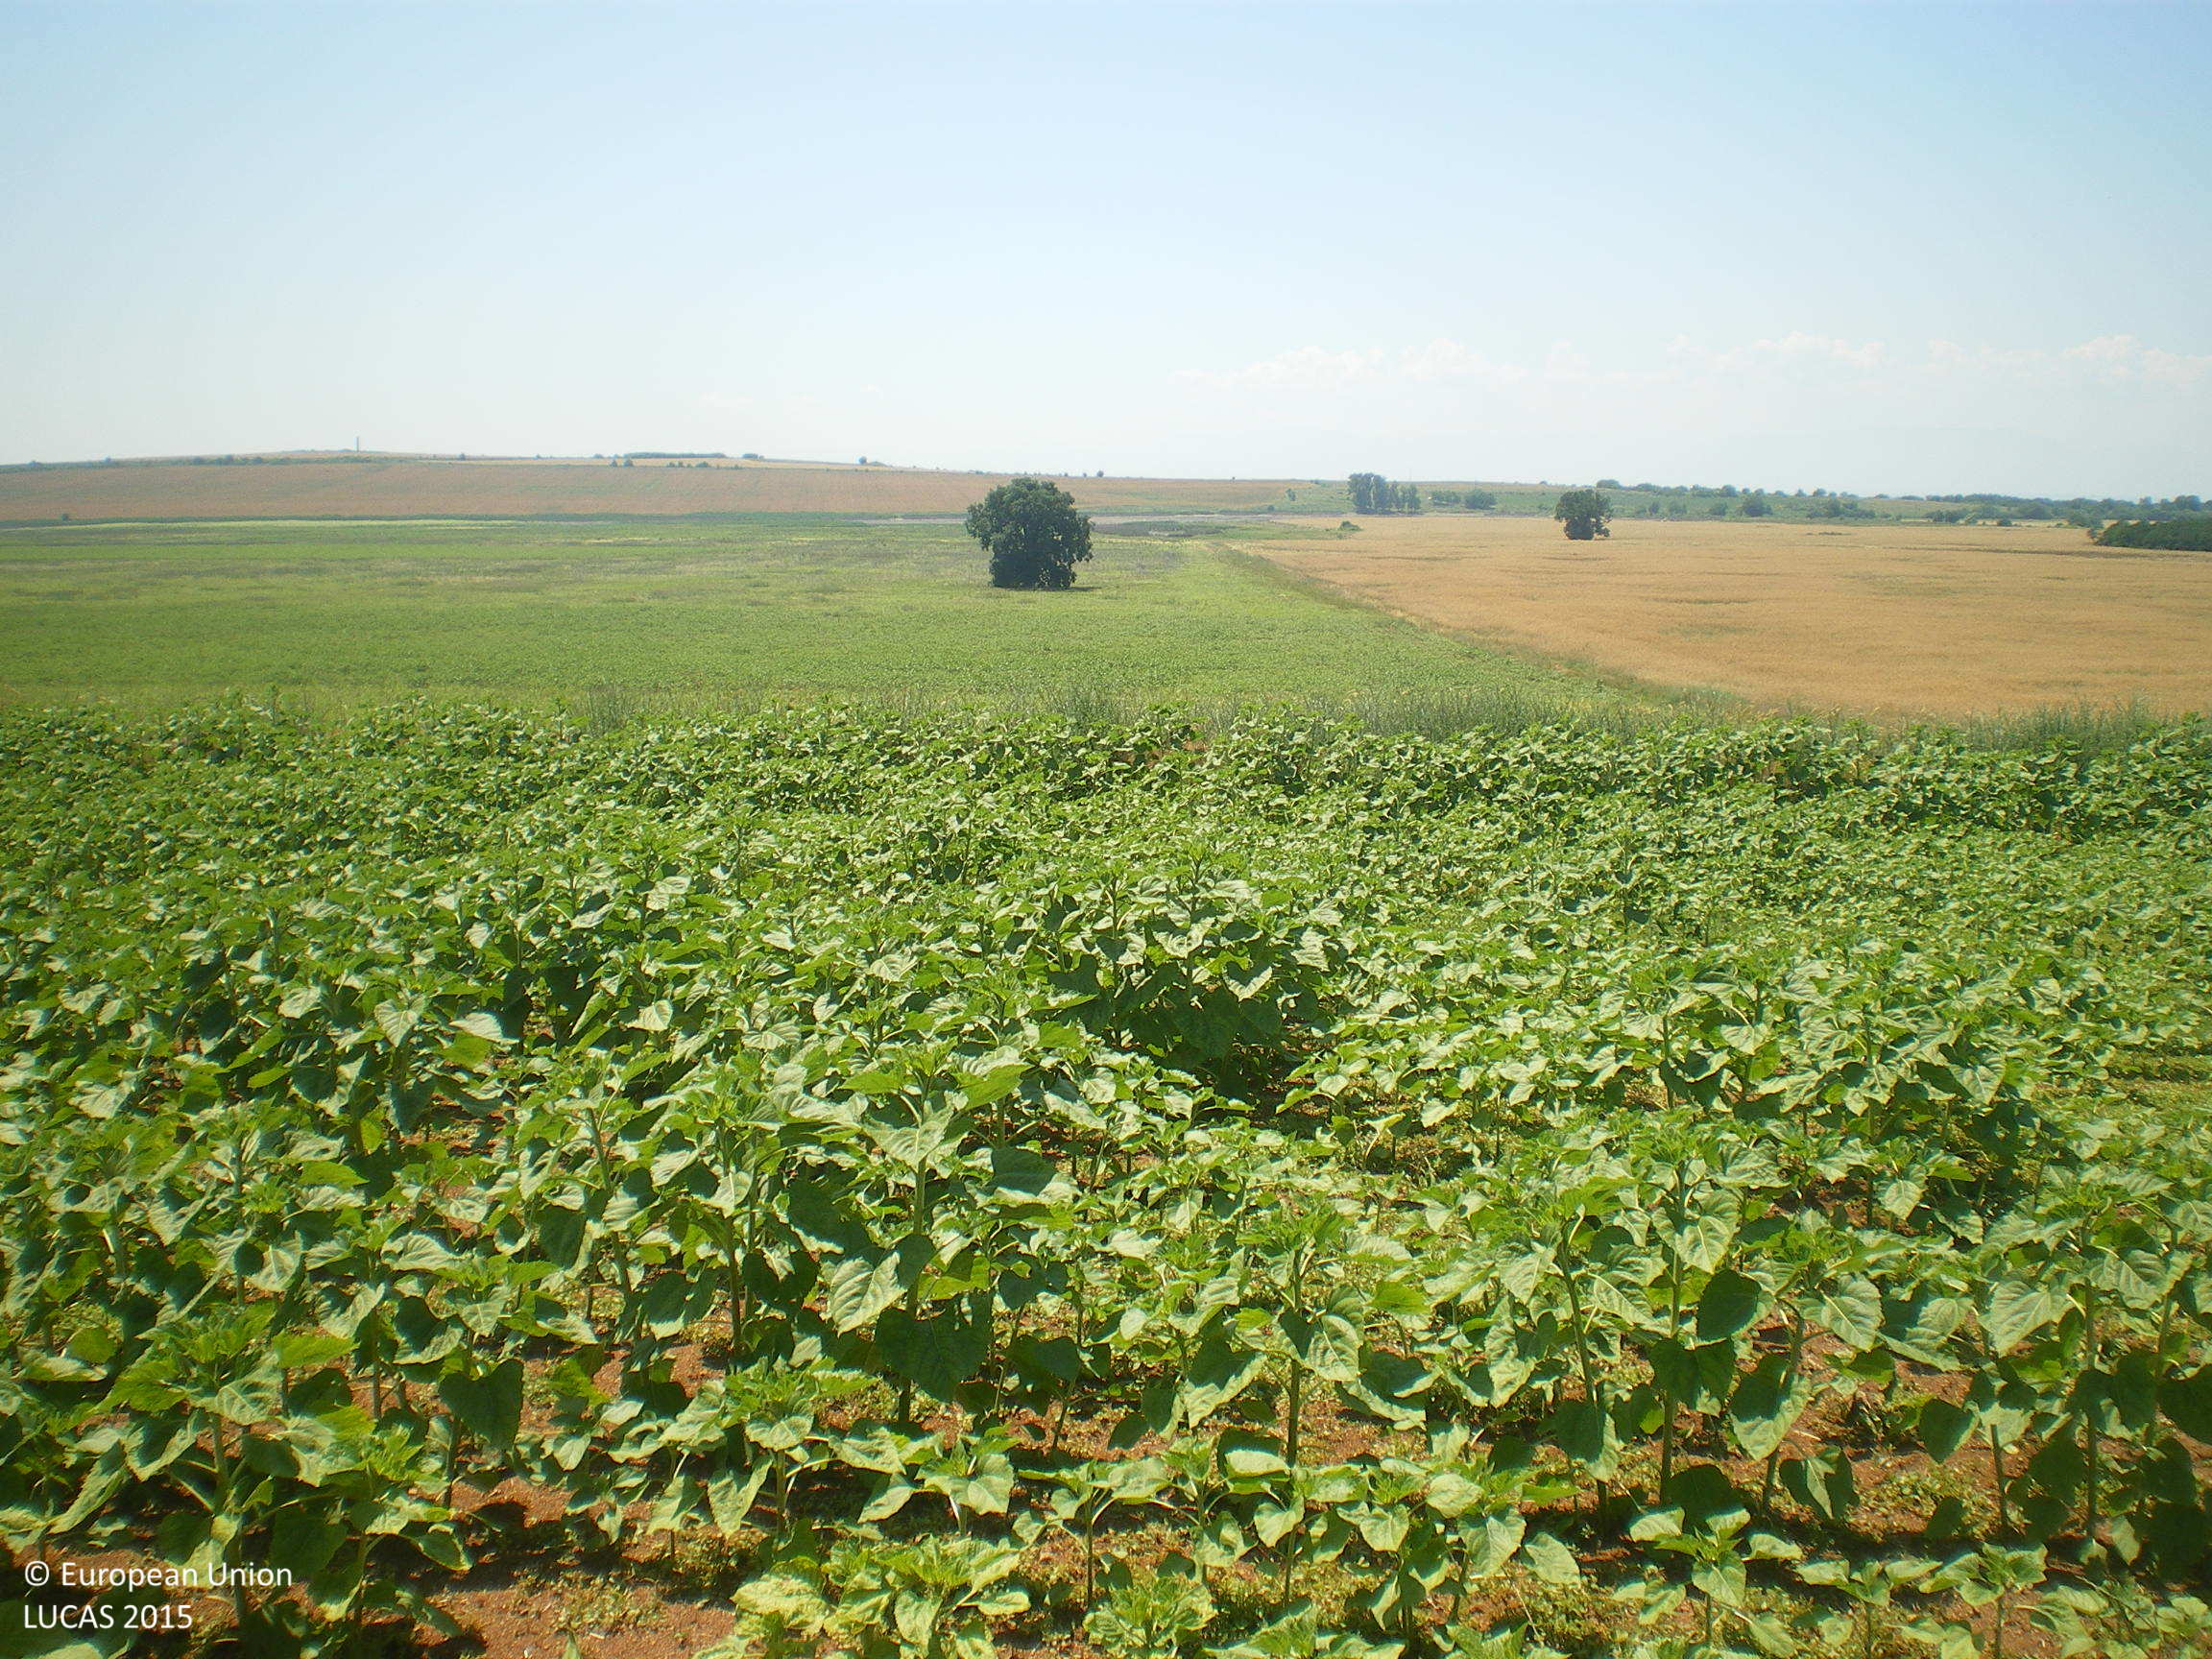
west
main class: Cropland
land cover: Sunflower
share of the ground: 50 - 75 %
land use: Agriculture (excluding fallow land and kitchen gardens)
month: June
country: BG
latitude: 42.2974
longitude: 25.1374
